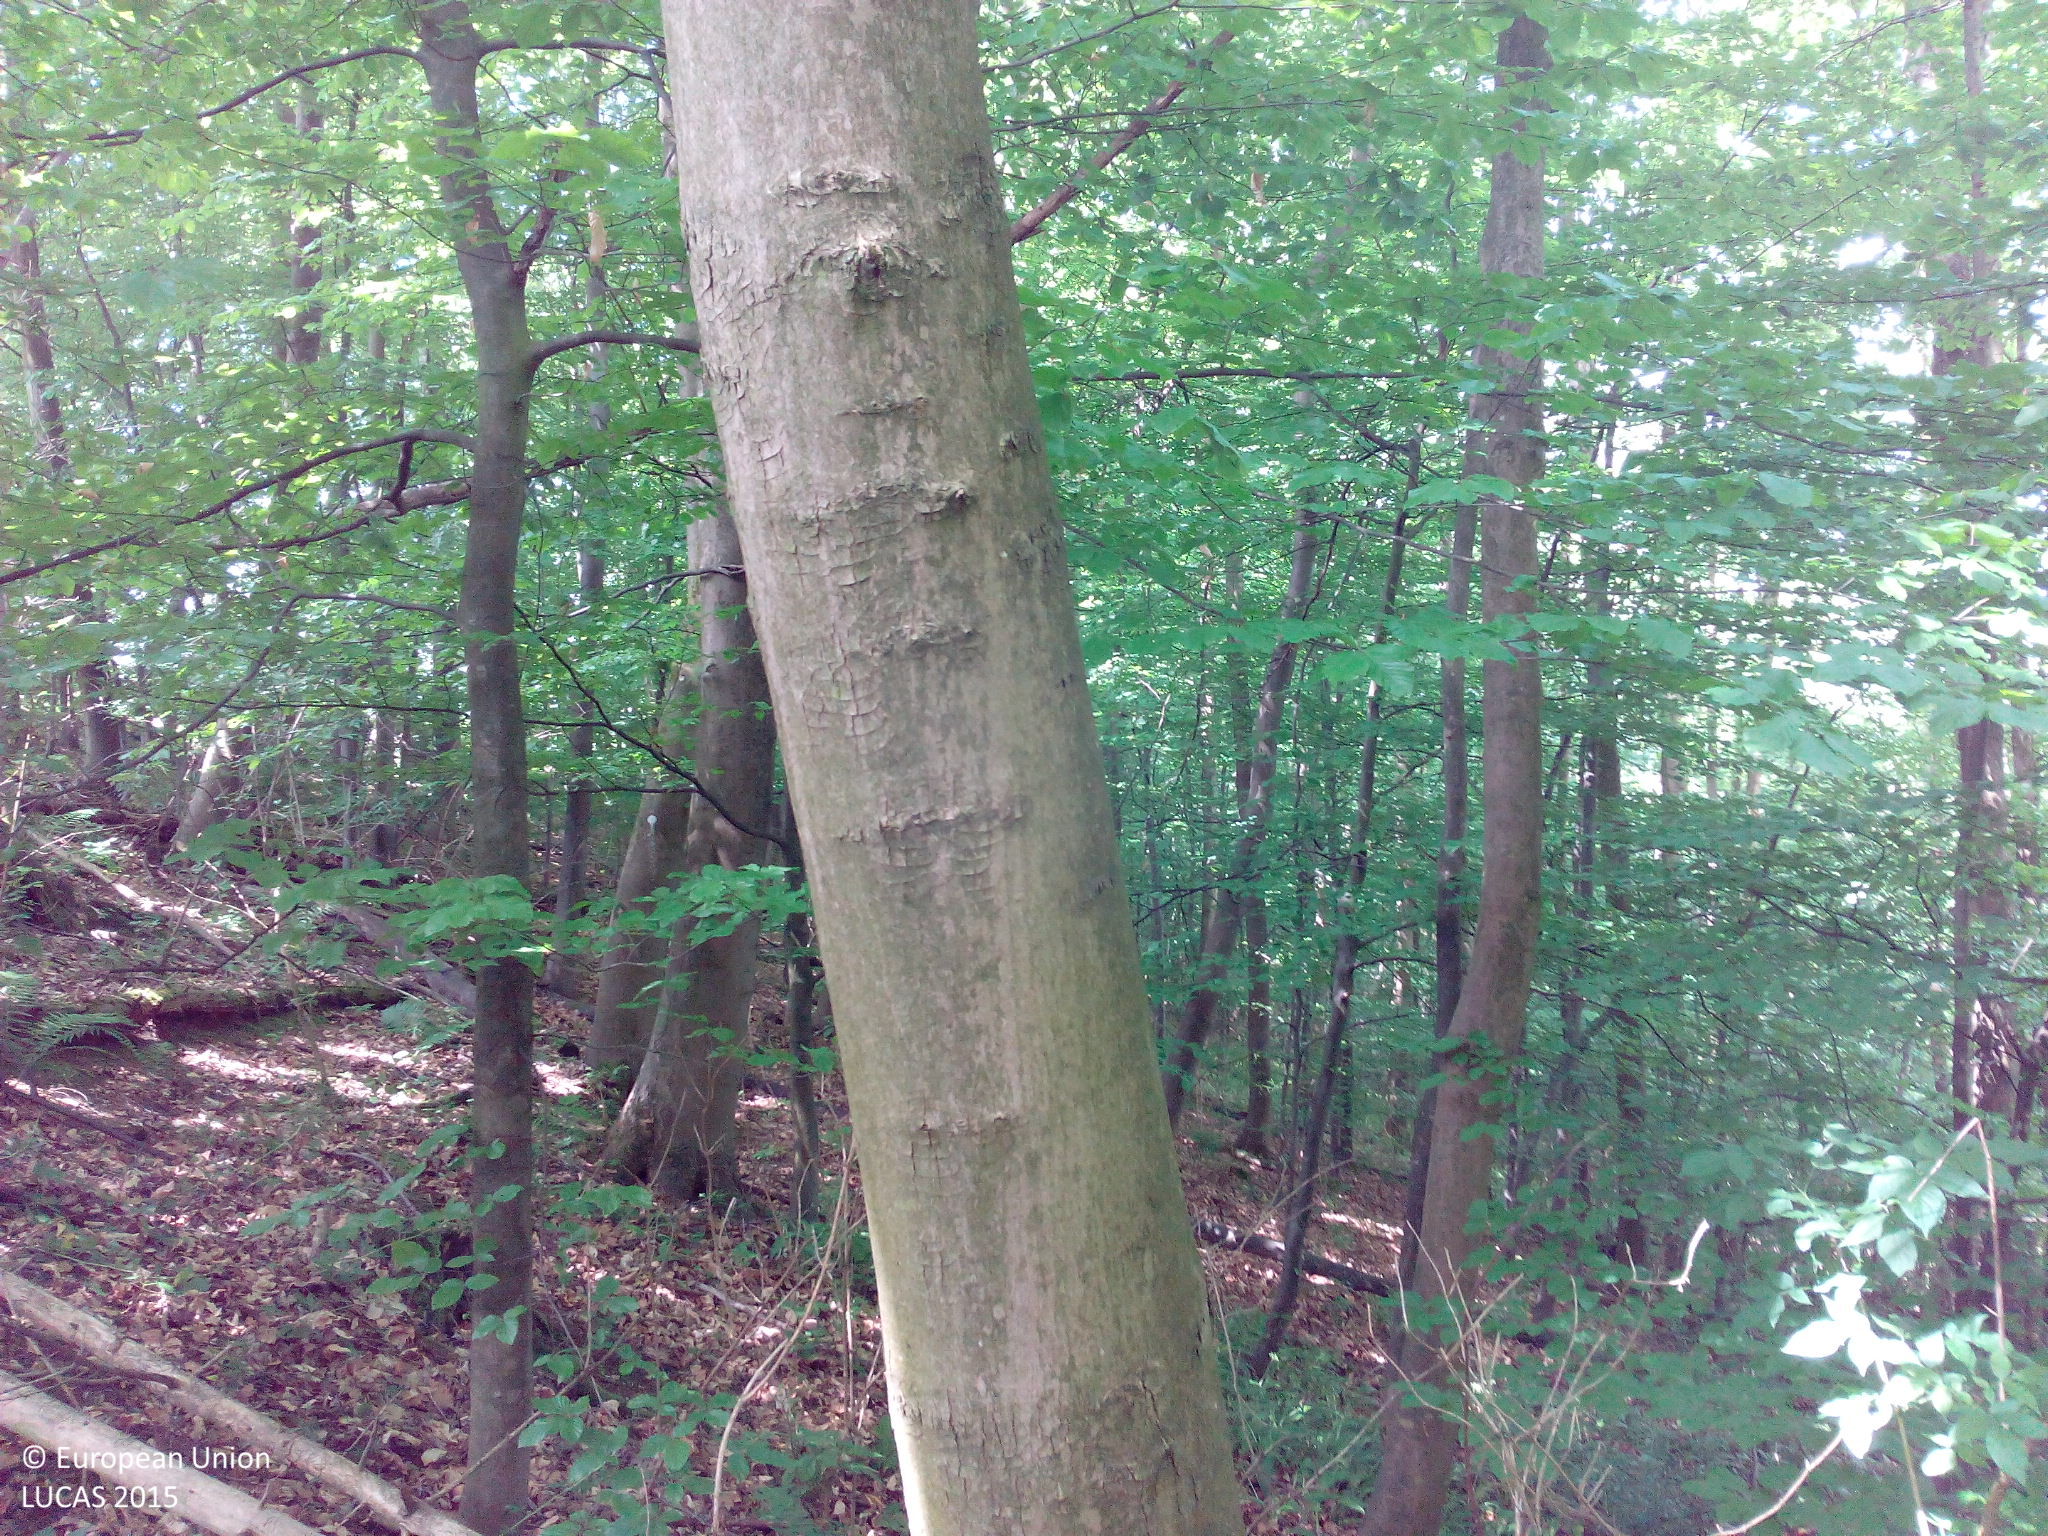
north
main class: Woodland
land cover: Broadleaved woodland
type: mesophytic deciduous forest
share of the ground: > 75 %
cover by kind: broadleaved forest trees 85 %, shrubs 10 %, coniferous forest trees 5 %
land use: Forestry
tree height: > 5 m
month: June
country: DE
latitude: 49.0495
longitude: 9.3846
